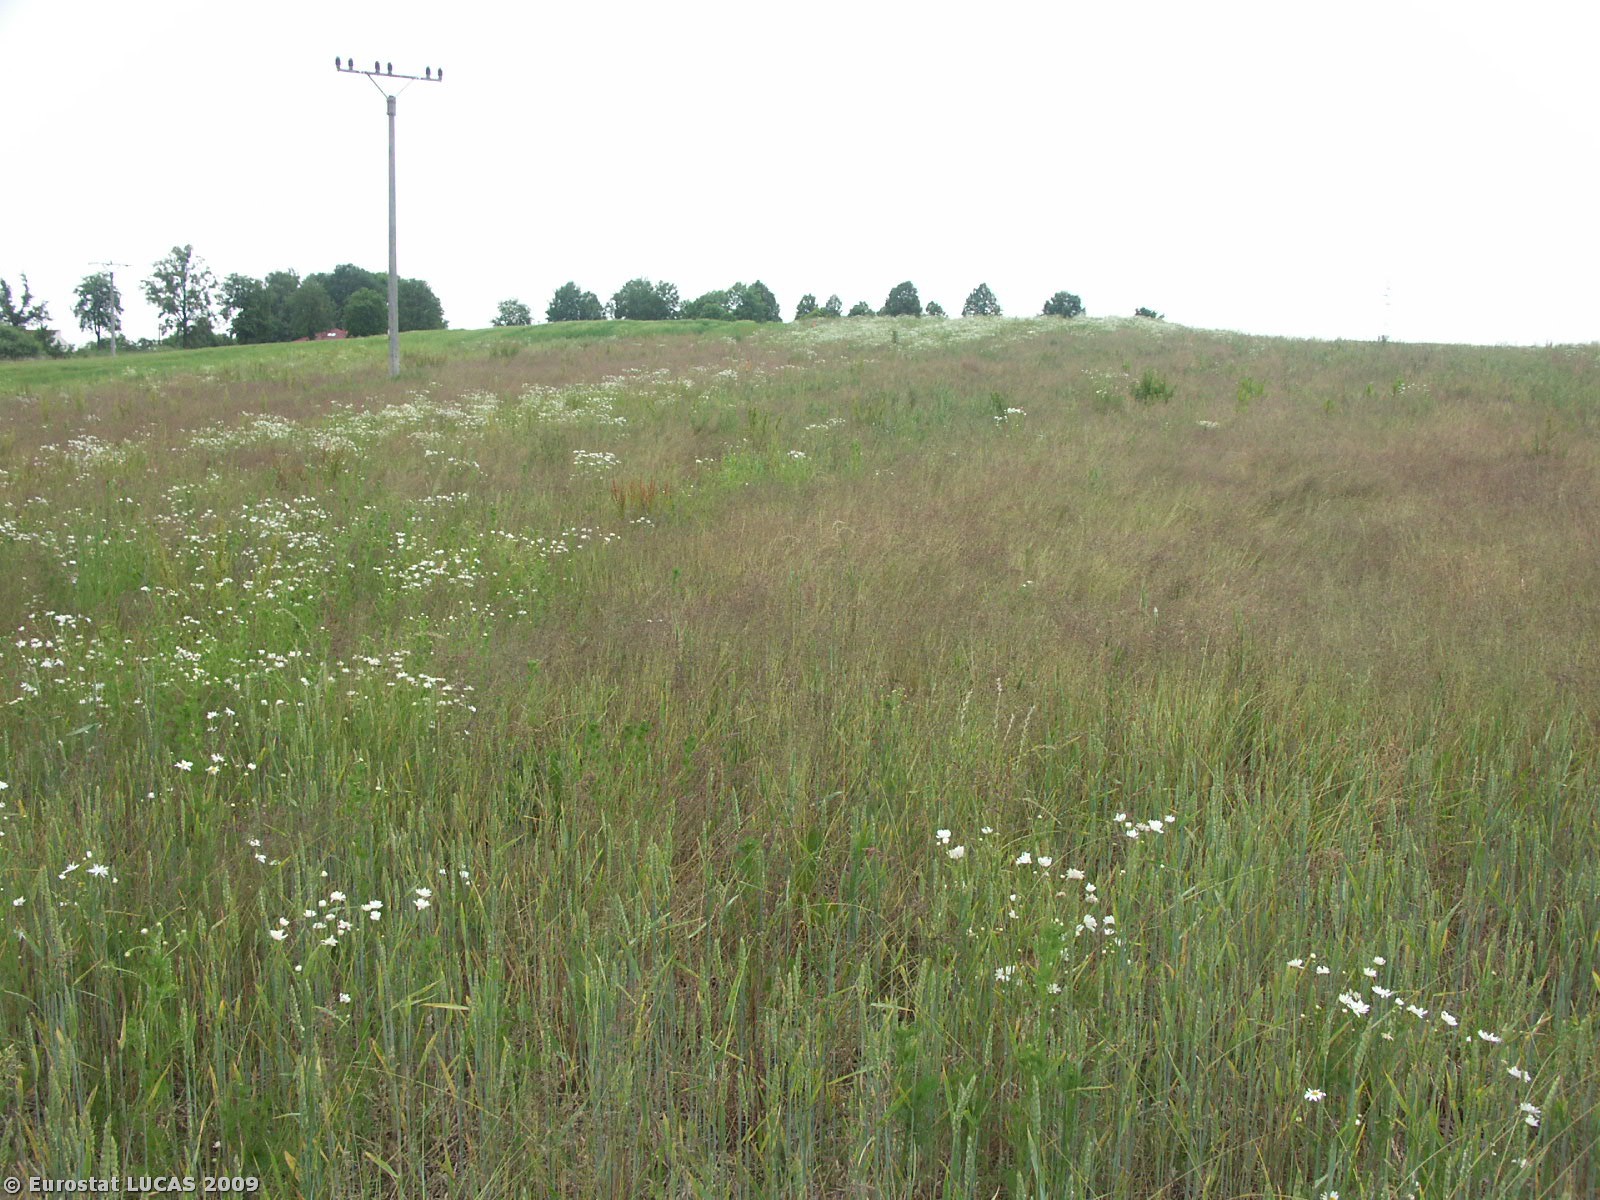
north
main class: Grassland
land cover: Spontaneously vegetated surfaces
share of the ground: > 75 %
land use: Fallow land
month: June
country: CZ
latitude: 48.9373
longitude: 14.6292
